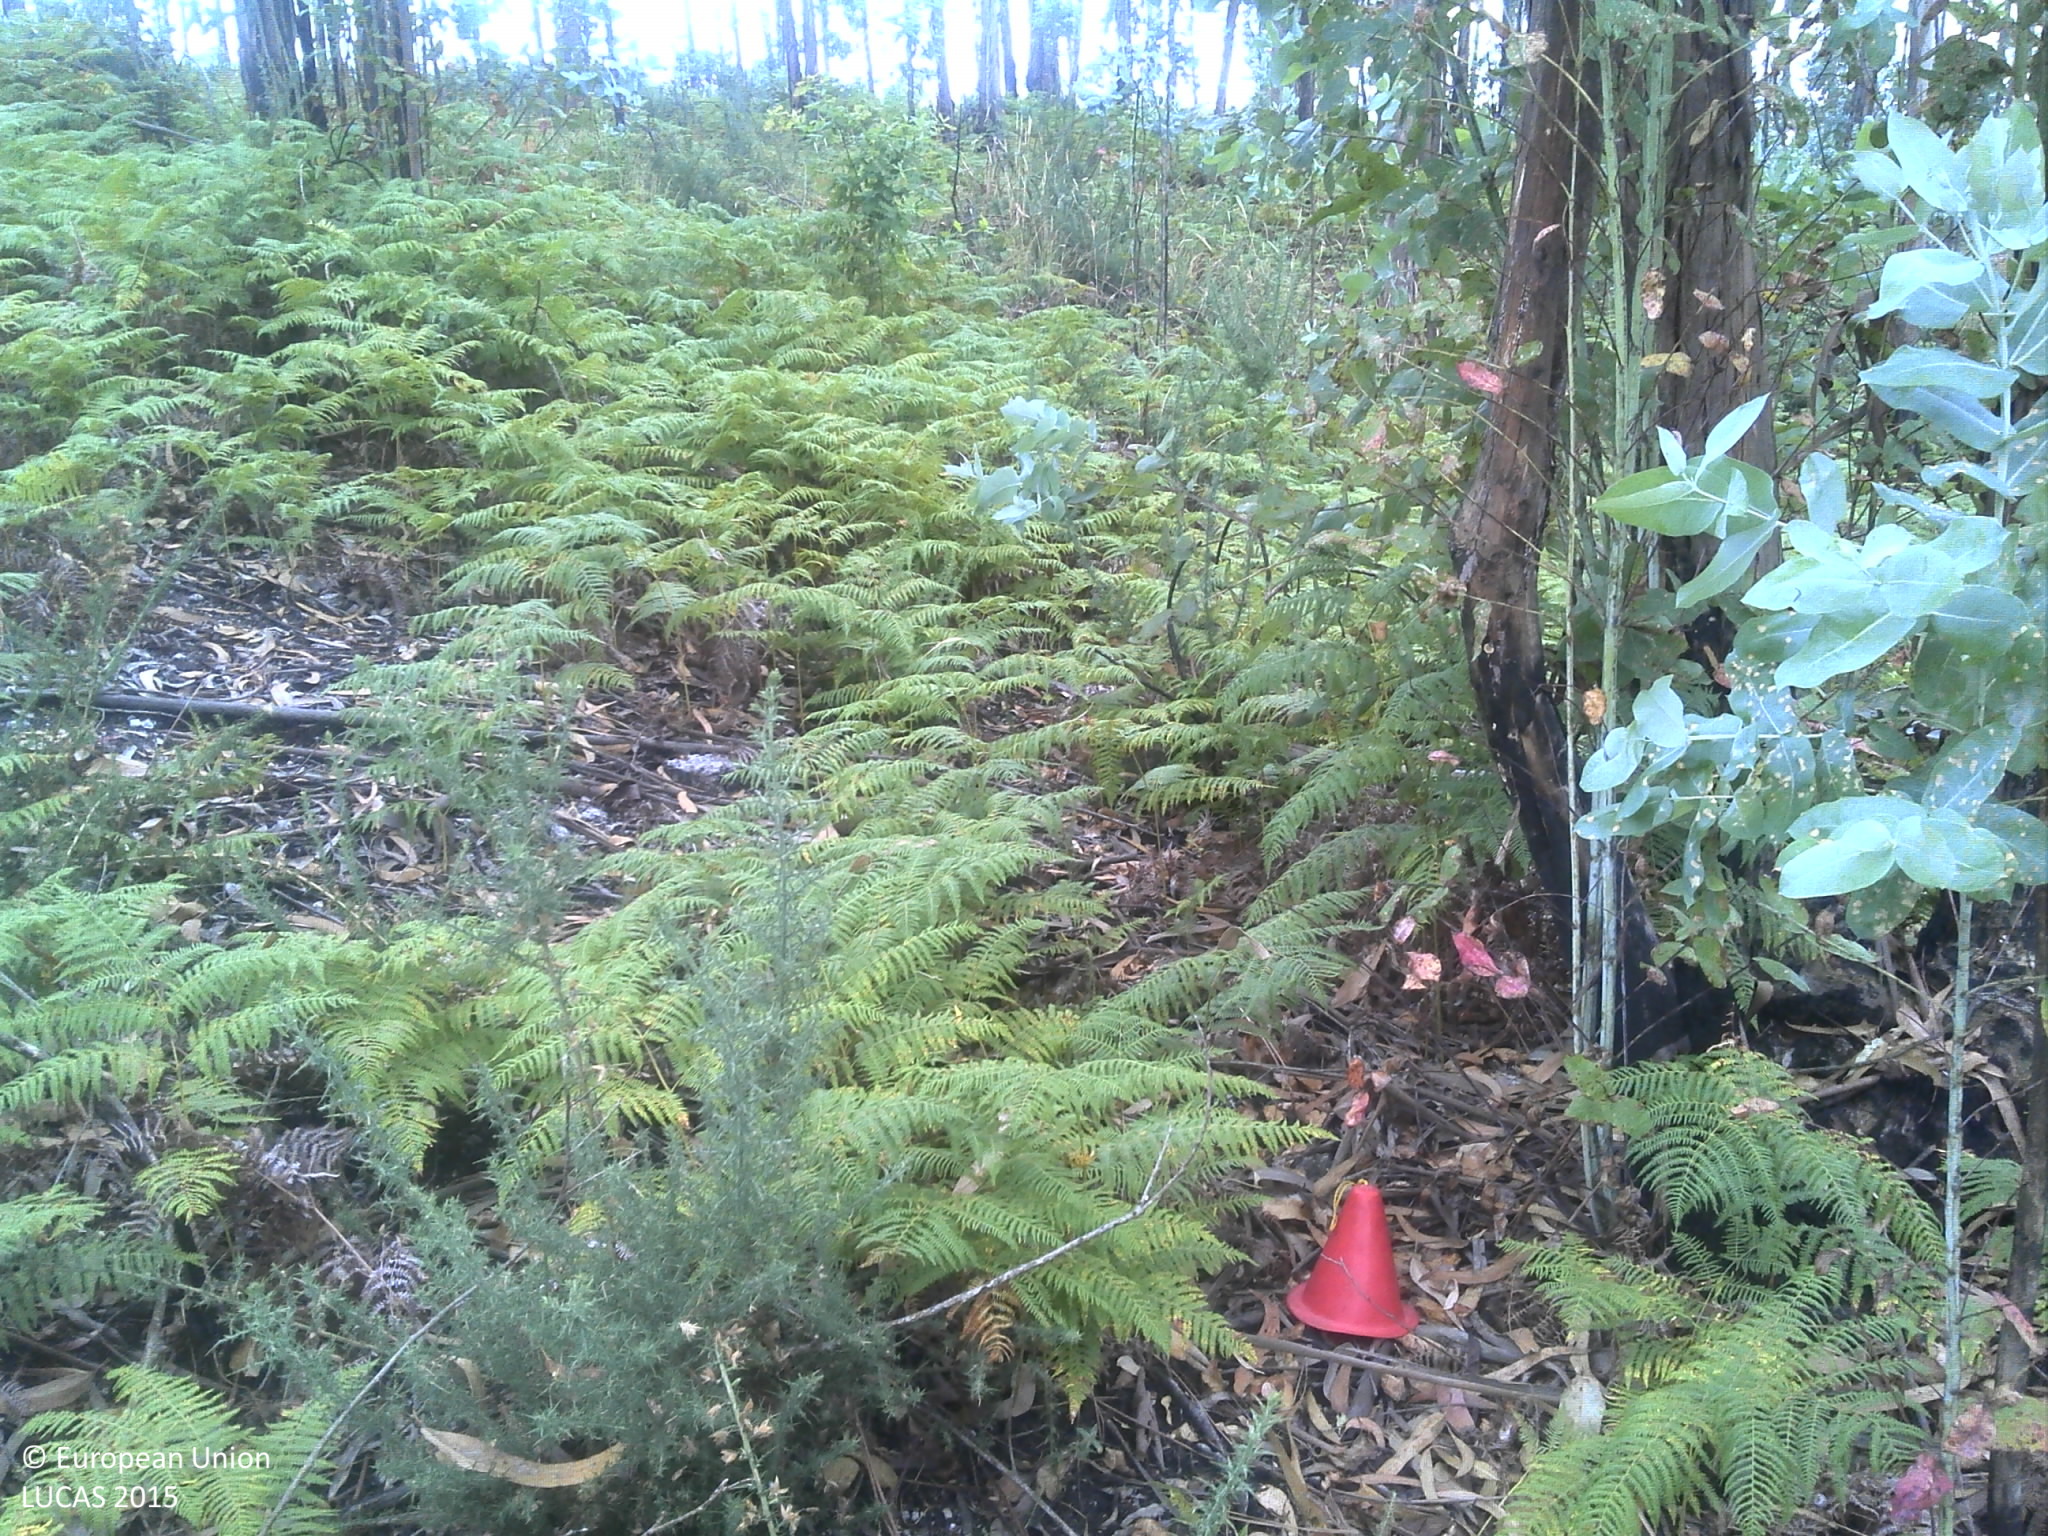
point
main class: Woodland
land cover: Broadleaved woodland
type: exotic forest
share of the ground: 50 - 75 %
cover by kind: broadleaved forest trees 70 %, shrubs 25 %, unconsolidated bare surface 5 %
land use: Forestry
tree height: > 5 m
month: June
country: PT
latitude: 41.2912
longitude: -8.1612
